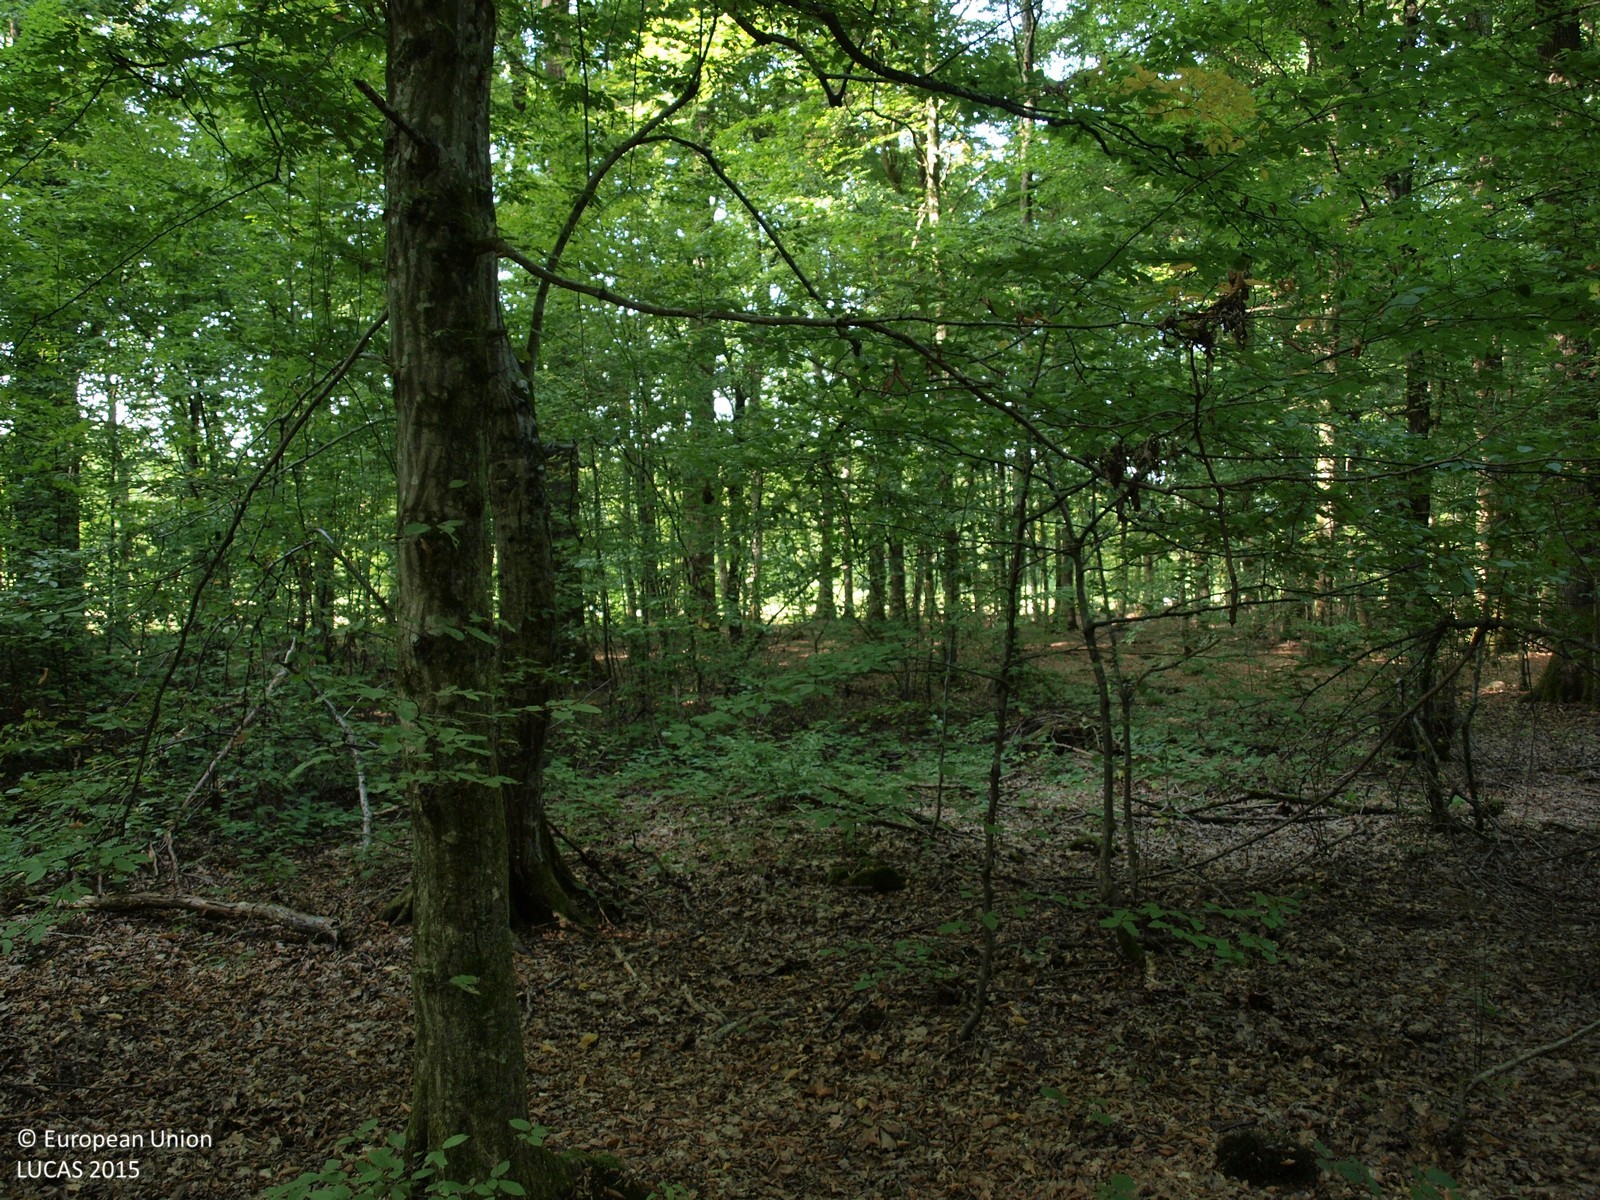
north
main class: Woodland
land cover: Broadleaved woodland
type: mesophytic deciduous forest
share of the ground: > 75 %
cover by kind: broadleaved forest trees 100 %
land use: Forestry
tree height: > 5 m
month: September
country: HR
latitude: 45.6177
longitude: 16.0892
